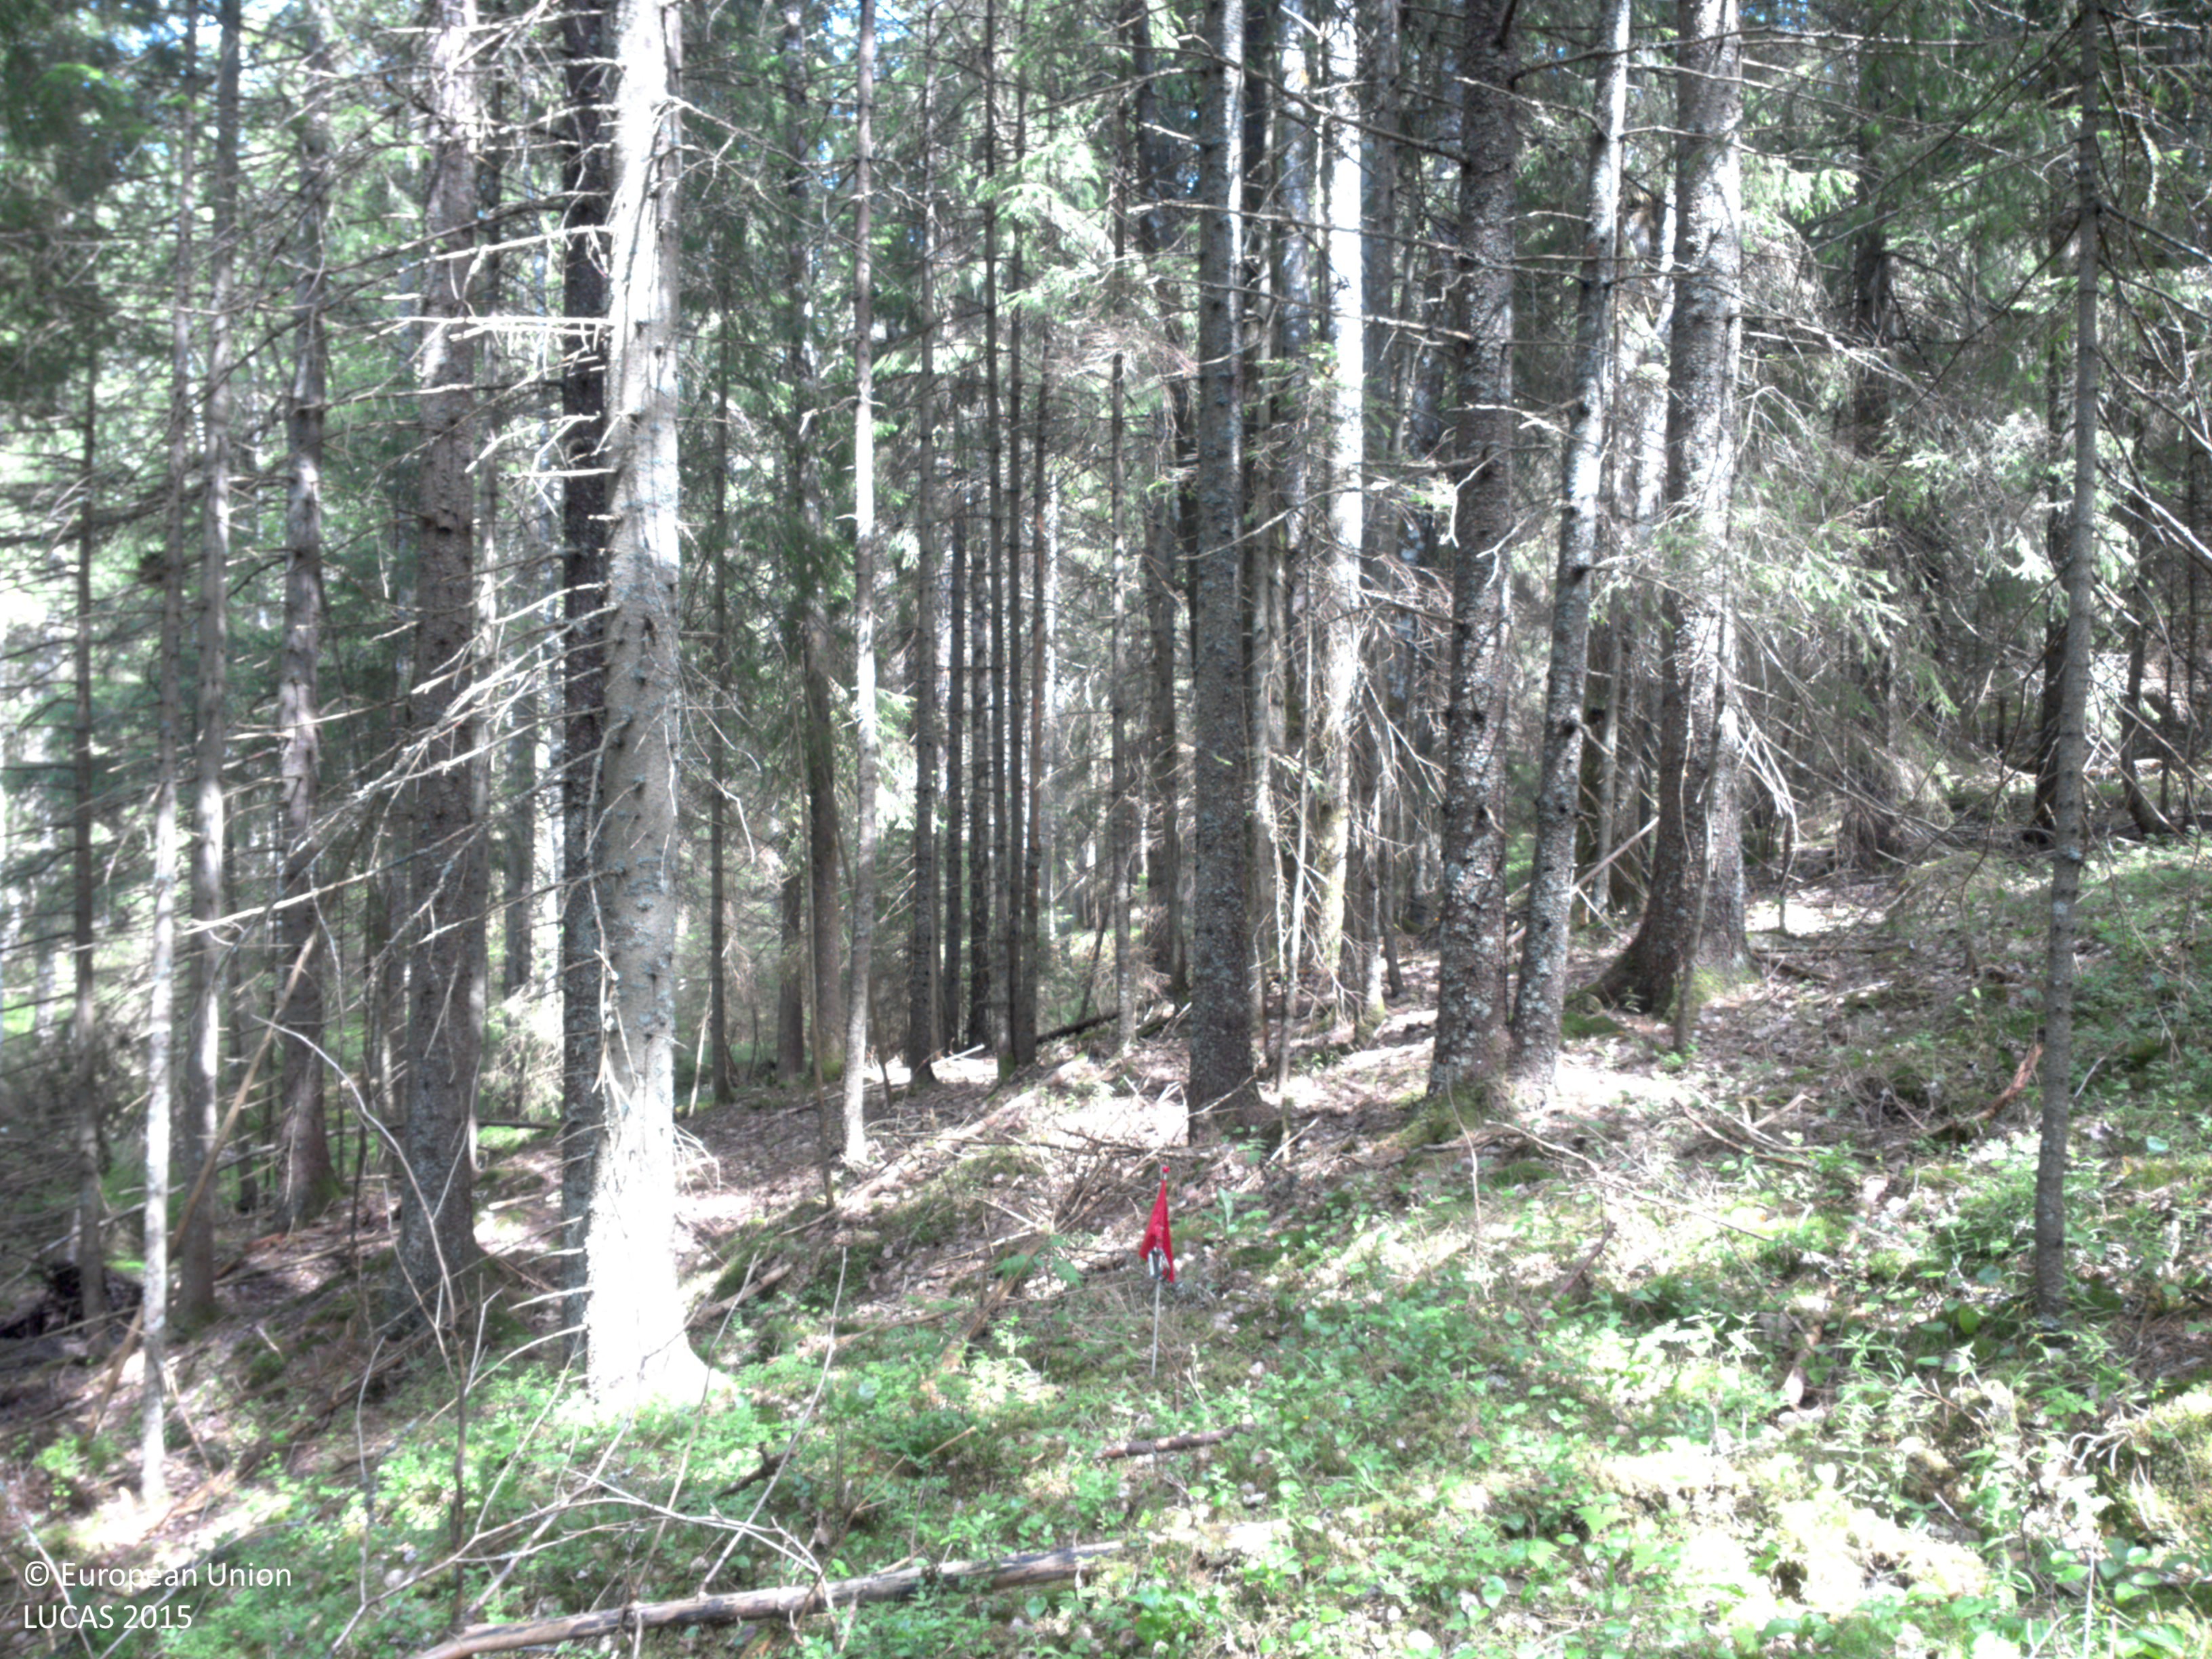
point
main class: Woodland
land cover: Spruce dominated coniferous woodland
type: boreal forest
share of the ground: 50 - 75 %
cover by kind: coniferous forest trees 65 %, lichens and mosses 20 %, shrubs 15 %
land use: Forestry
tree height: > 5 m
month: July
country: SE
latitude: 58.7991
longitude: 11.9513
